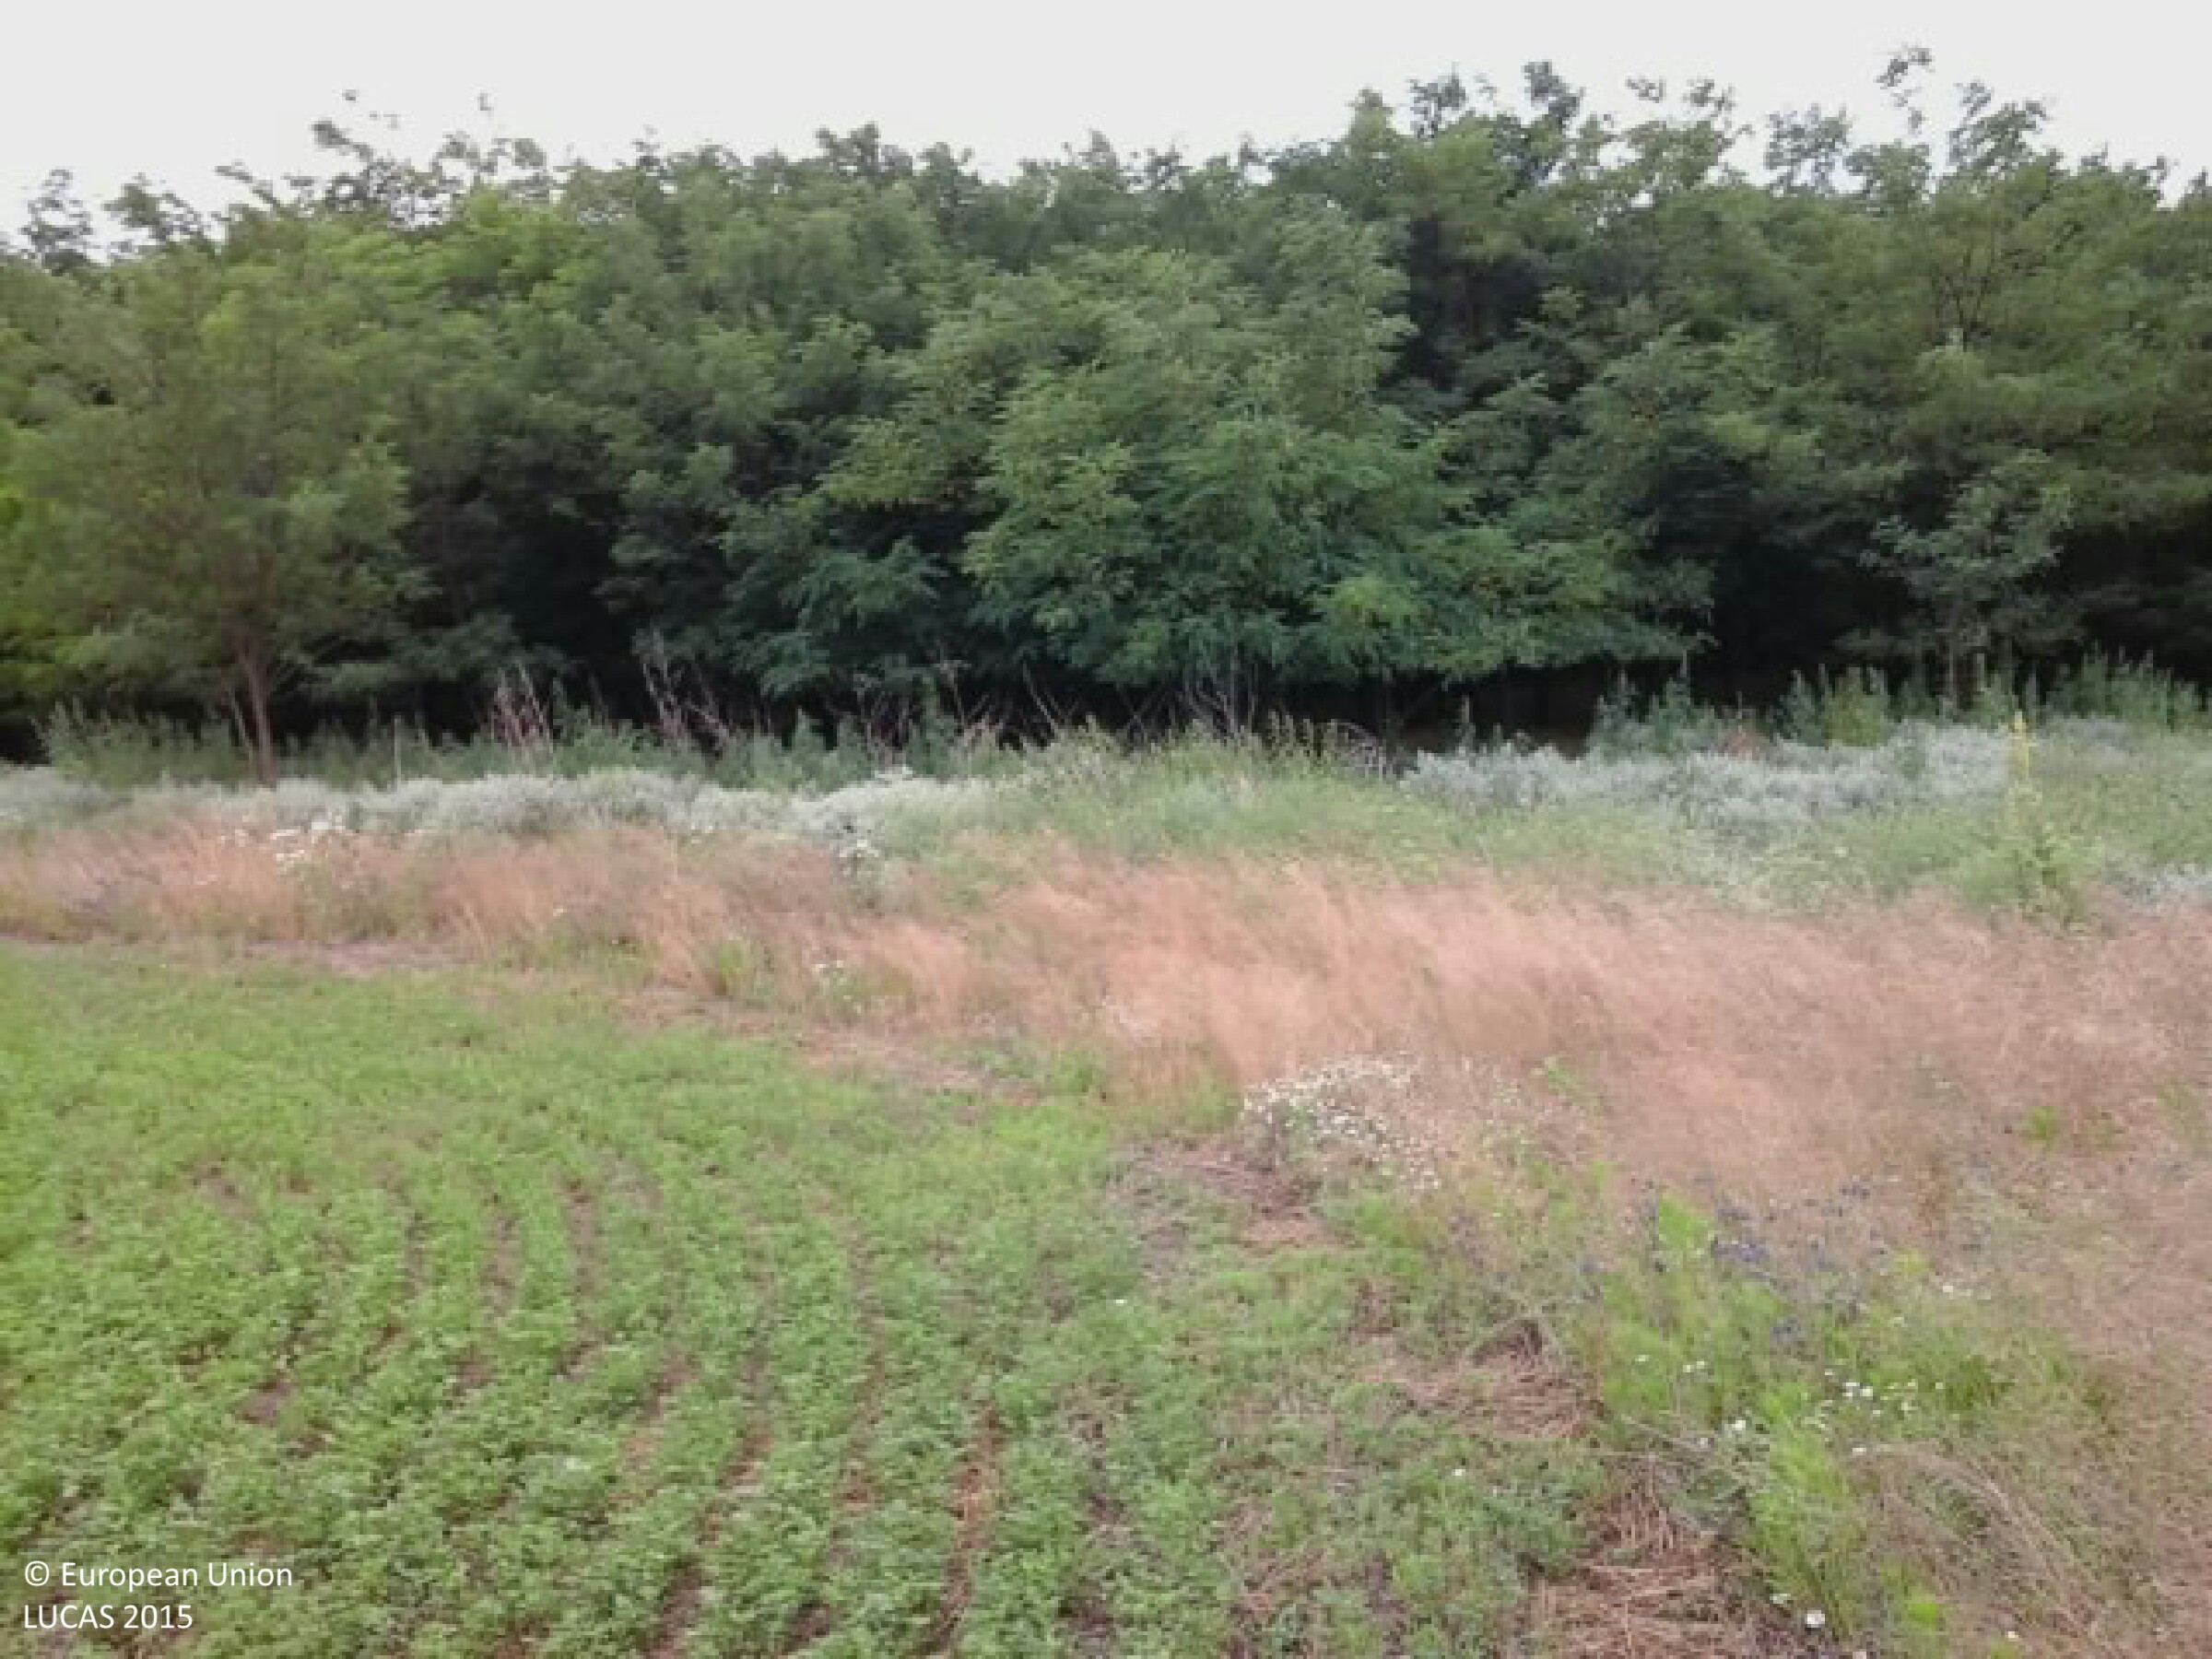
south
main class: Grassland
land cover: Grassland without tree/shrub cover
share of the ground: > 75 %
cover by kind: herbaceous plants 100 %
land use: Agriculture (excluding fallow land and kitchen gardens)
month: June
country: HU
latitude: 47.3765
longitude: 19.3036
